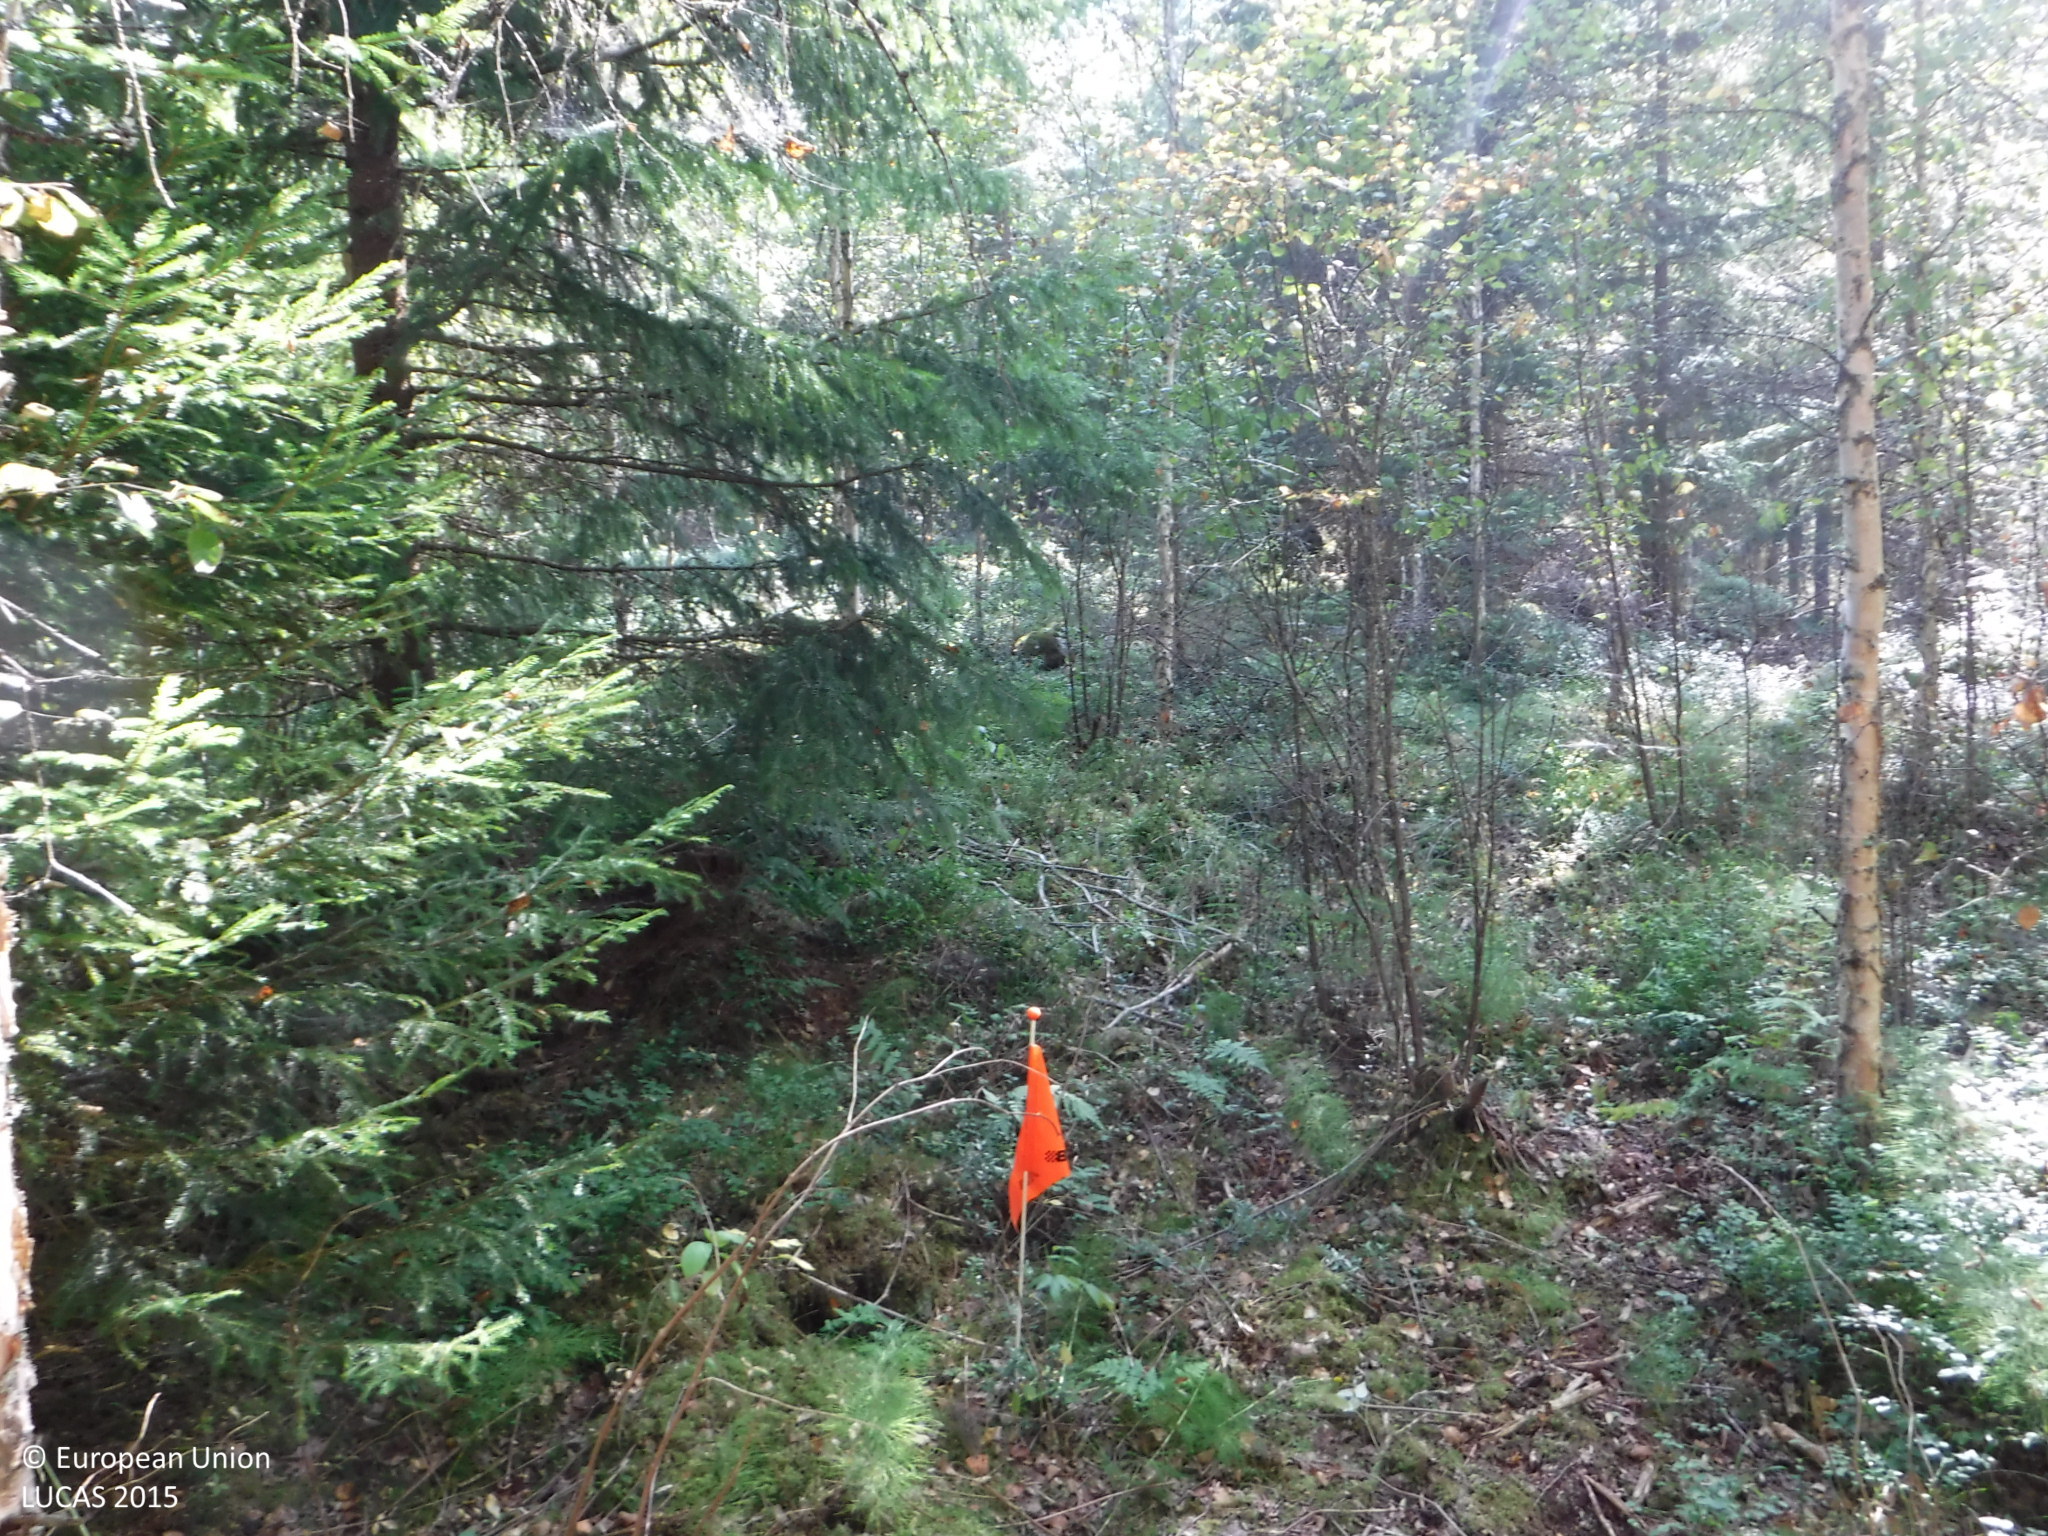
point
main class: Woodland
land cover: Spruce dominated mixed woodland
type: boreal forest
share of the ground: 50 - 75 %
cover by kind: coniferous forest trees 30 %, broadleaved forest trees 30 %, lichens and mosses 20 %, unconsolidated bare surface 10 %, shrubs 5 %, herbaceous plants 5 %
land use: Forestry
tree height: > 5 m
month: August
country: FI
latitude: 61.1631
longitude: 22.8396
